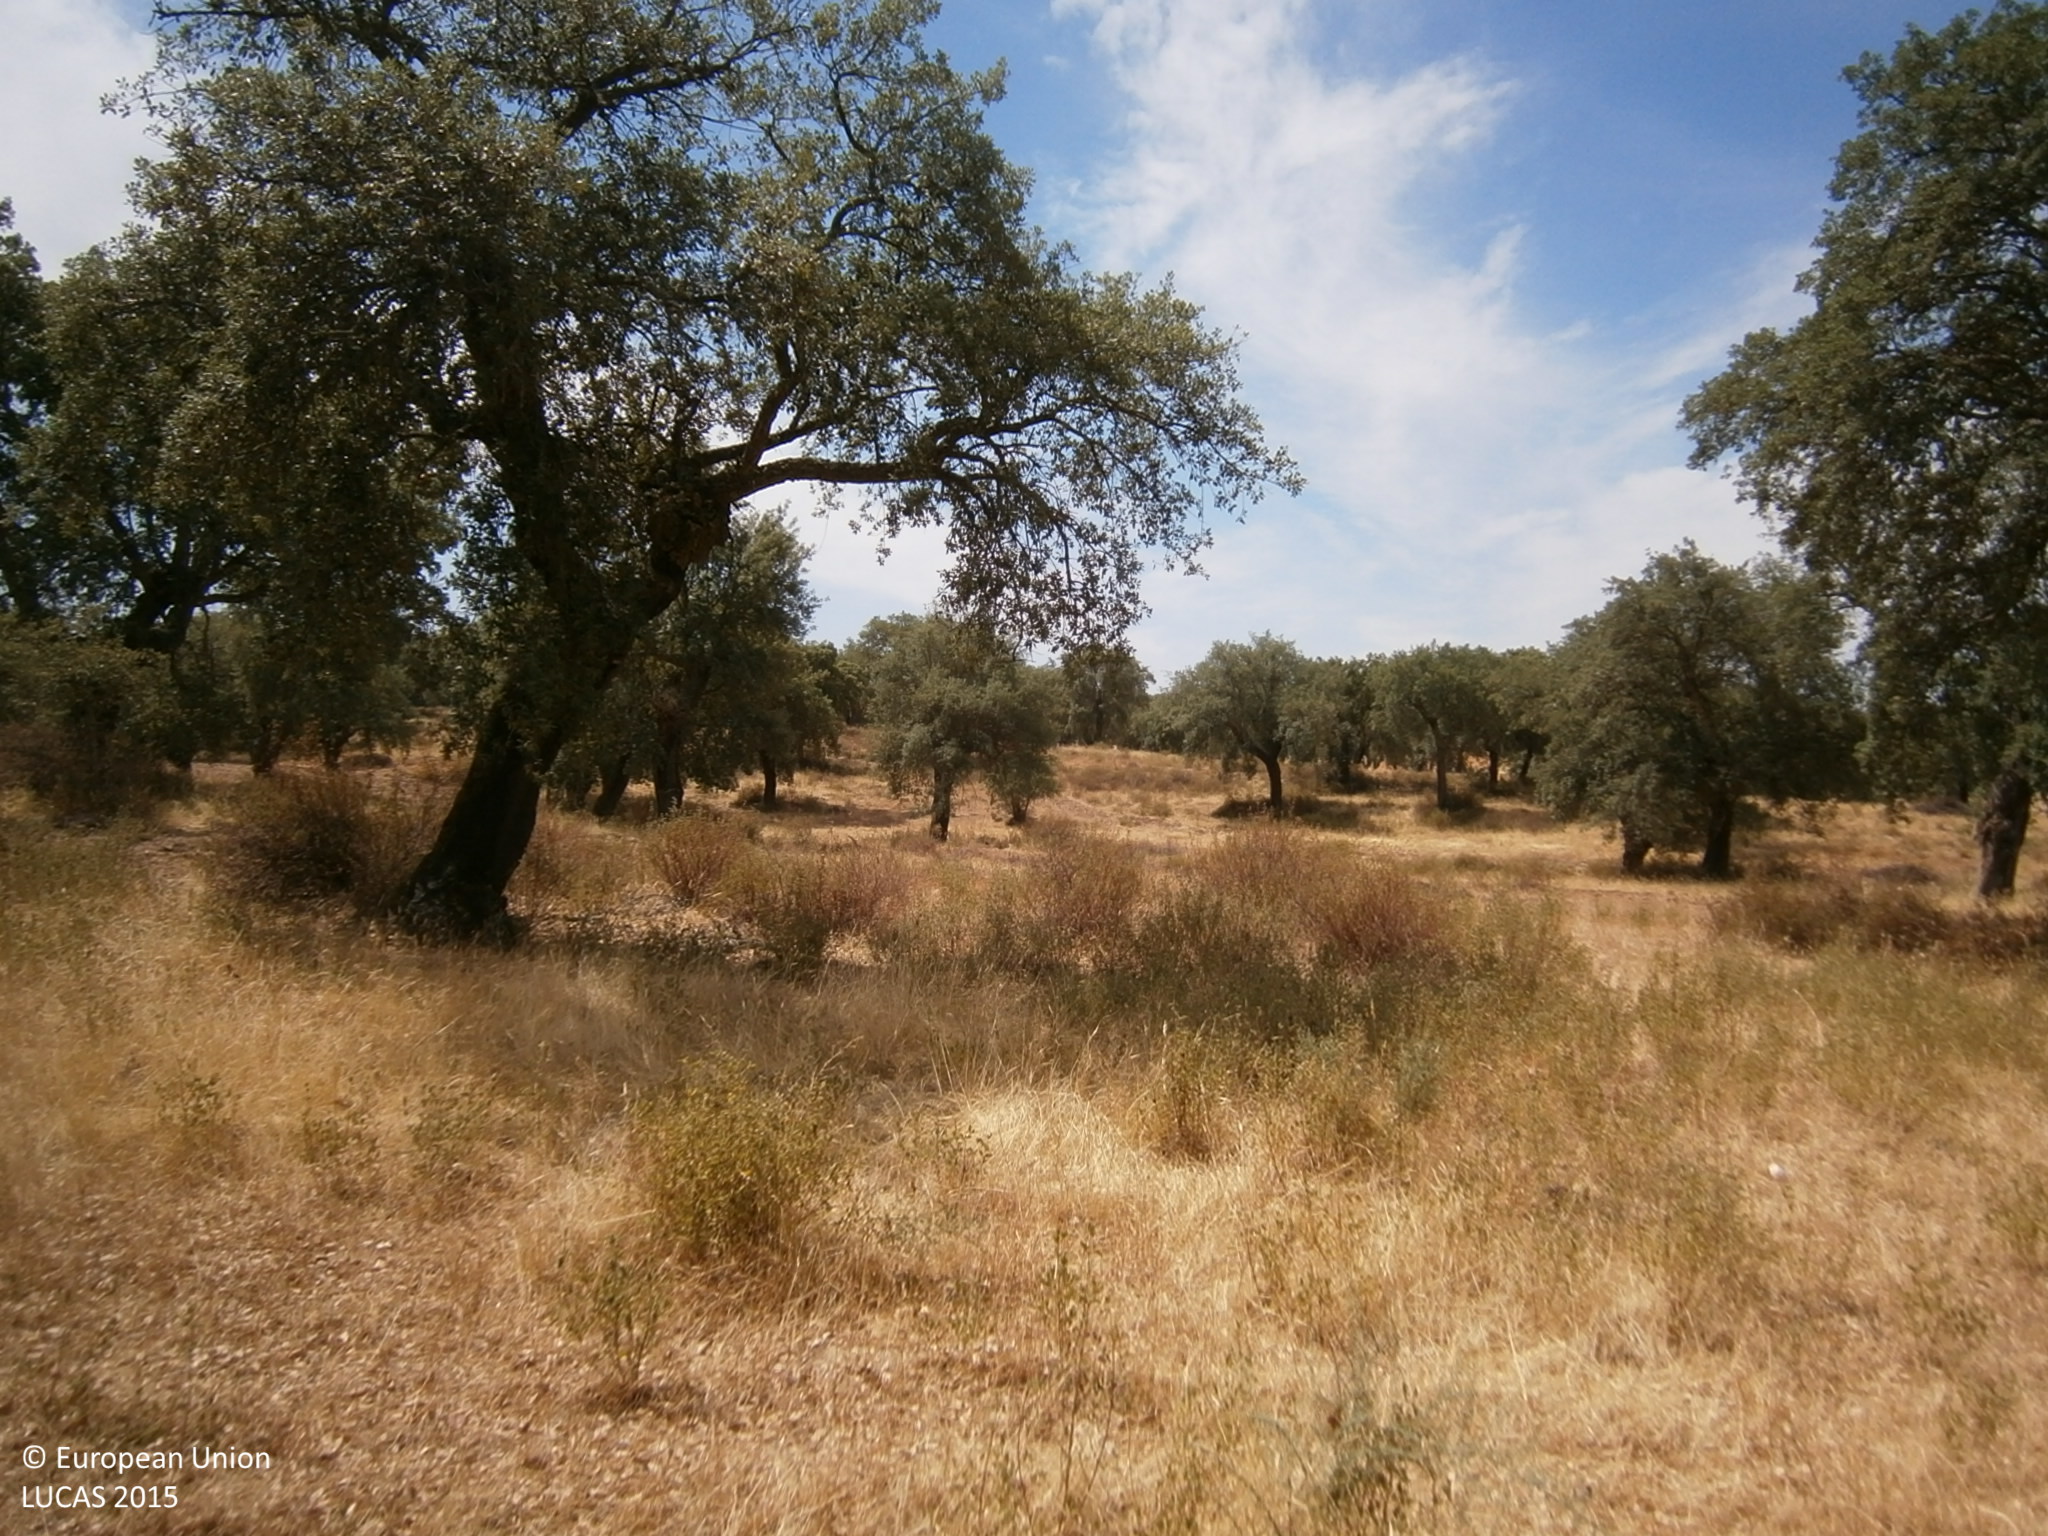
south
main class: Woodland
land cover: Broadleaved woodland
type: broadleaved evergreen forest
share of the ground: > 75 %
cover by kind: herbaceous plants 60 %, broadleaved forest trees 30 %, shrubs 10 %
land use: Forestry
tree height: > 5 m
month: July
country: ES
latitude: 38.7931
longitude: -6.9814
